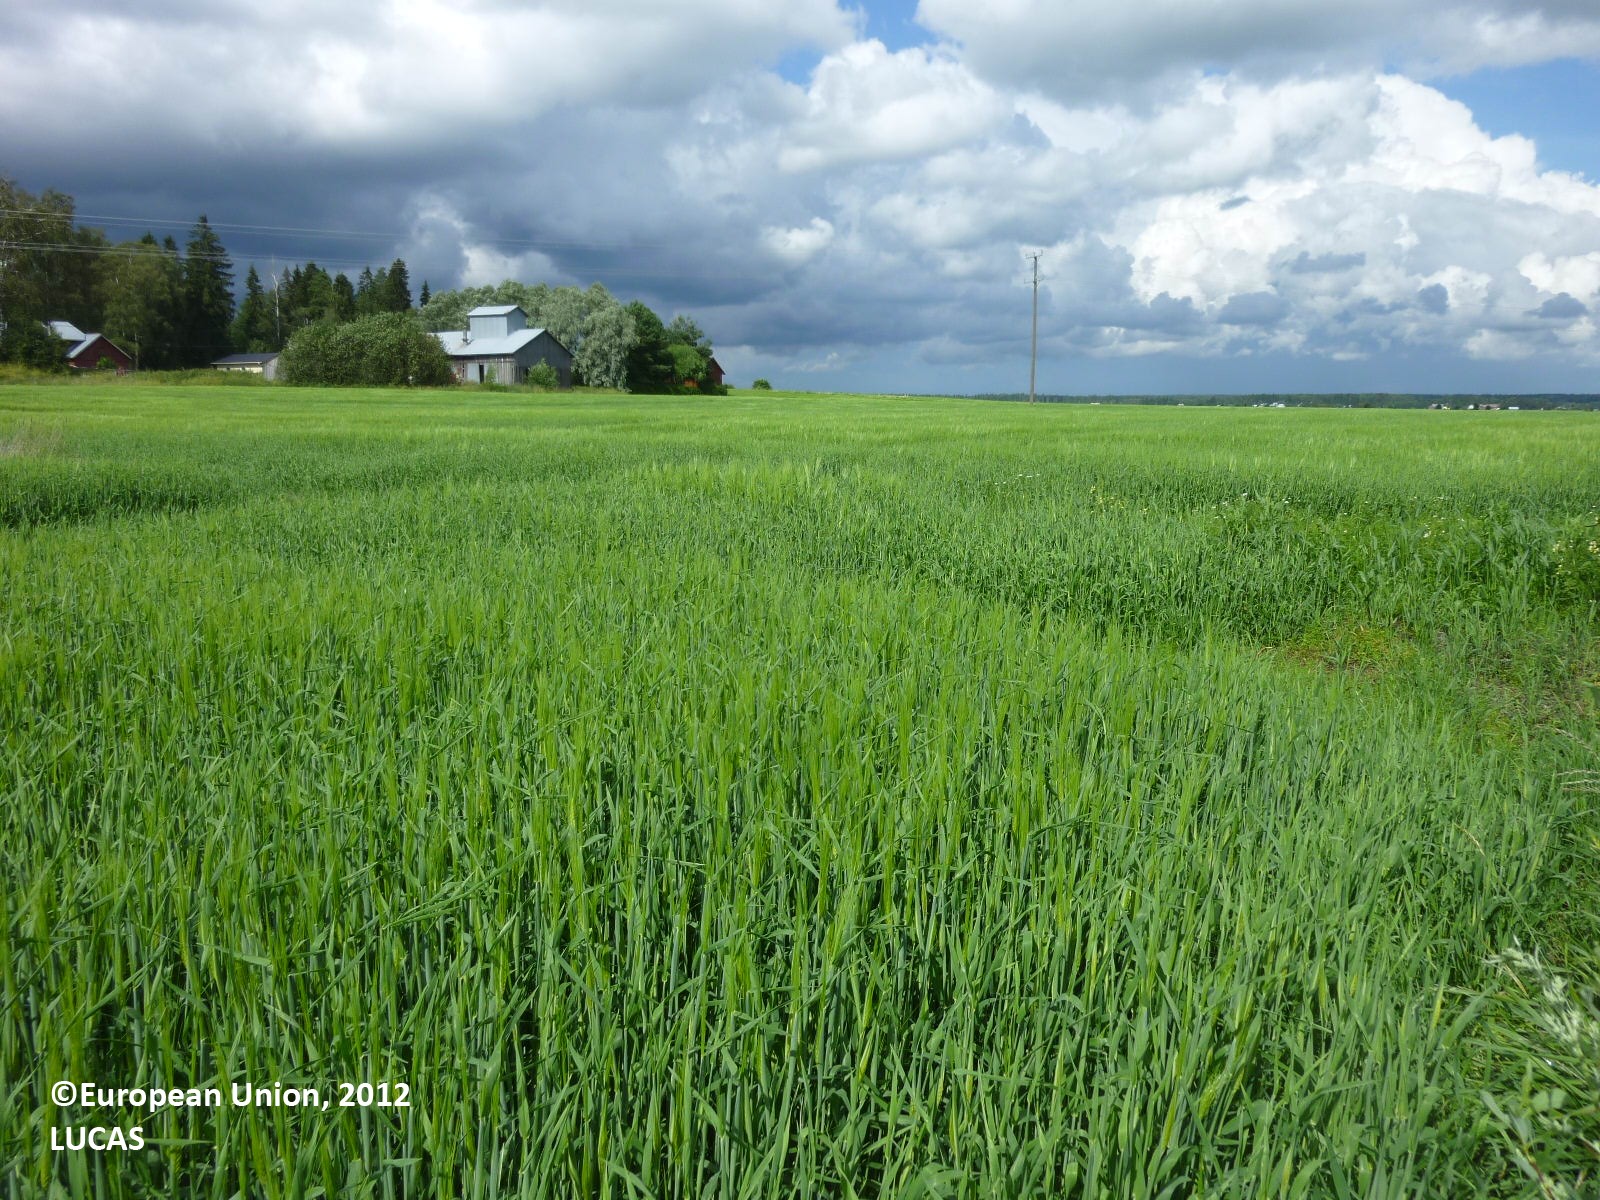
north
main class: Cropland
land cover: Barley
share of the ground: > 75 %
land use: Agriculture (excluding fallow land and kitchen gardens)
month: July
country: FI
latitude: 61.2239
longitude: 21.9196
